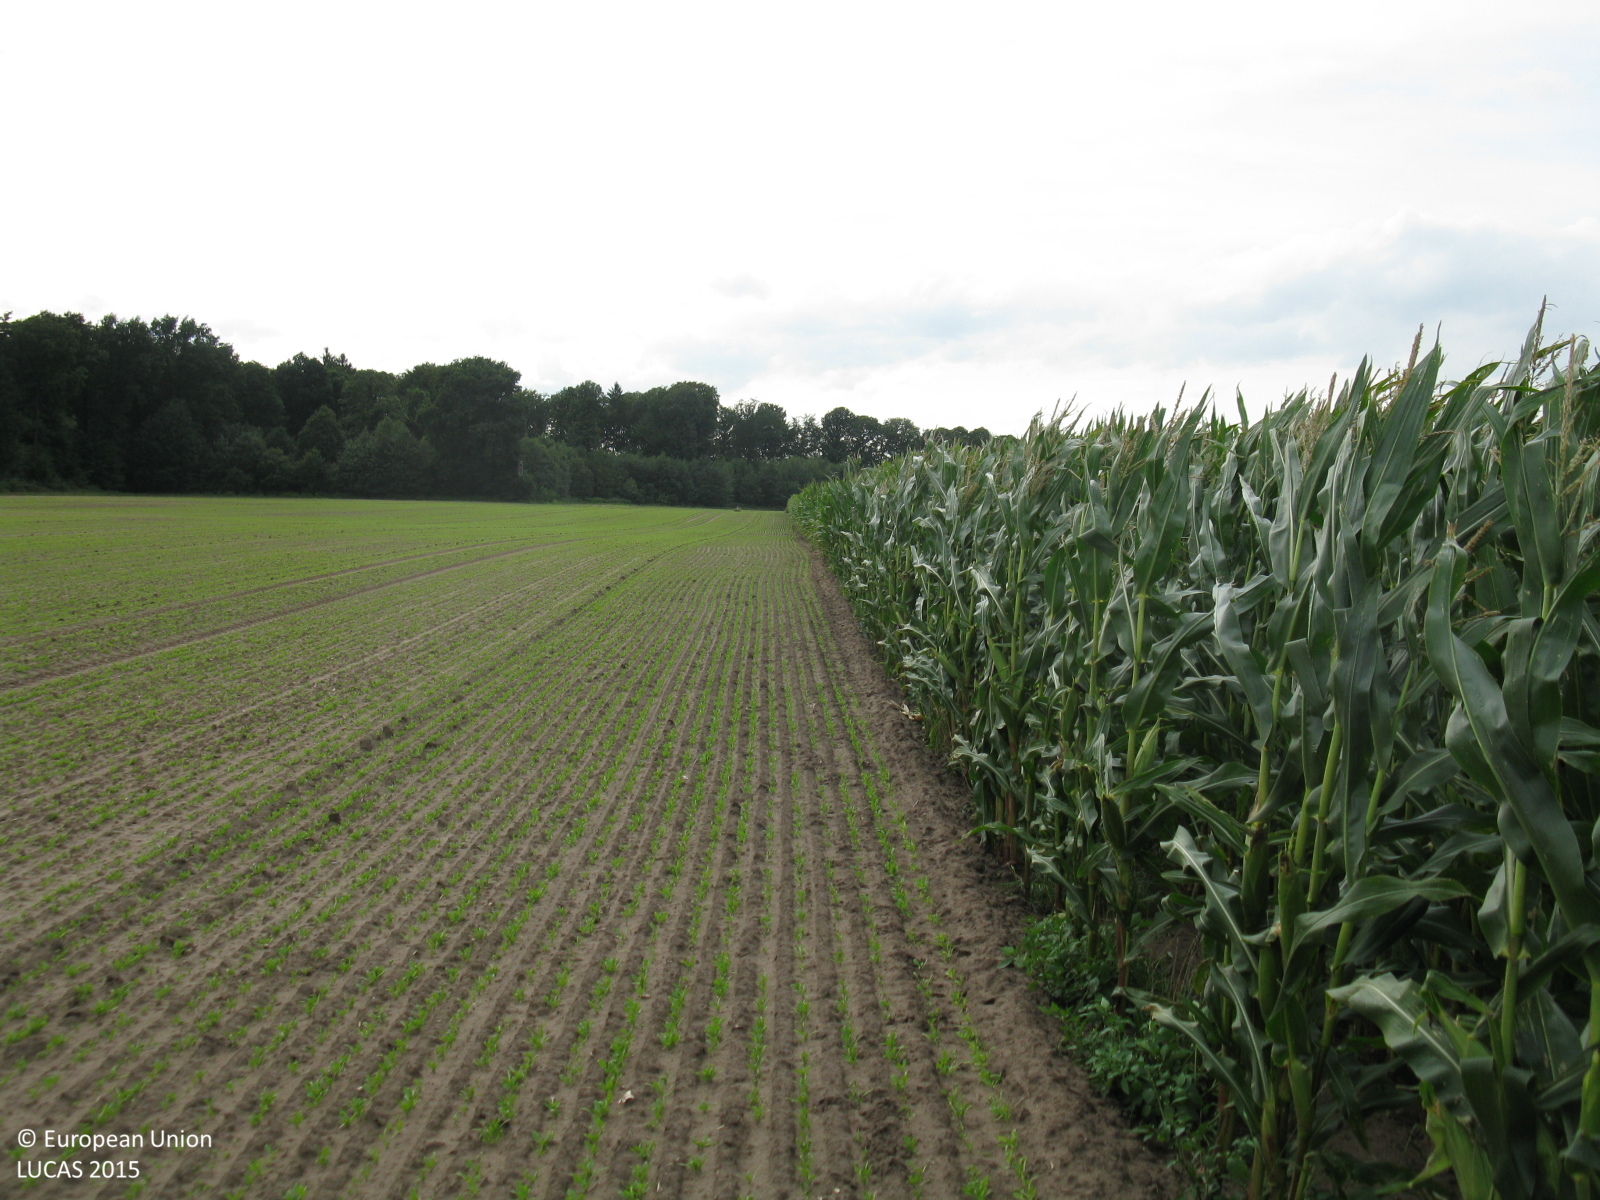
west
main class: Cropland
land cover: Maize
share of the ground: > 75 %
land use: Agriculture (excluding fallow land and kitchen gardens)
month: August
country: DE
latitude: 51.7999
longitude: 6.9983
